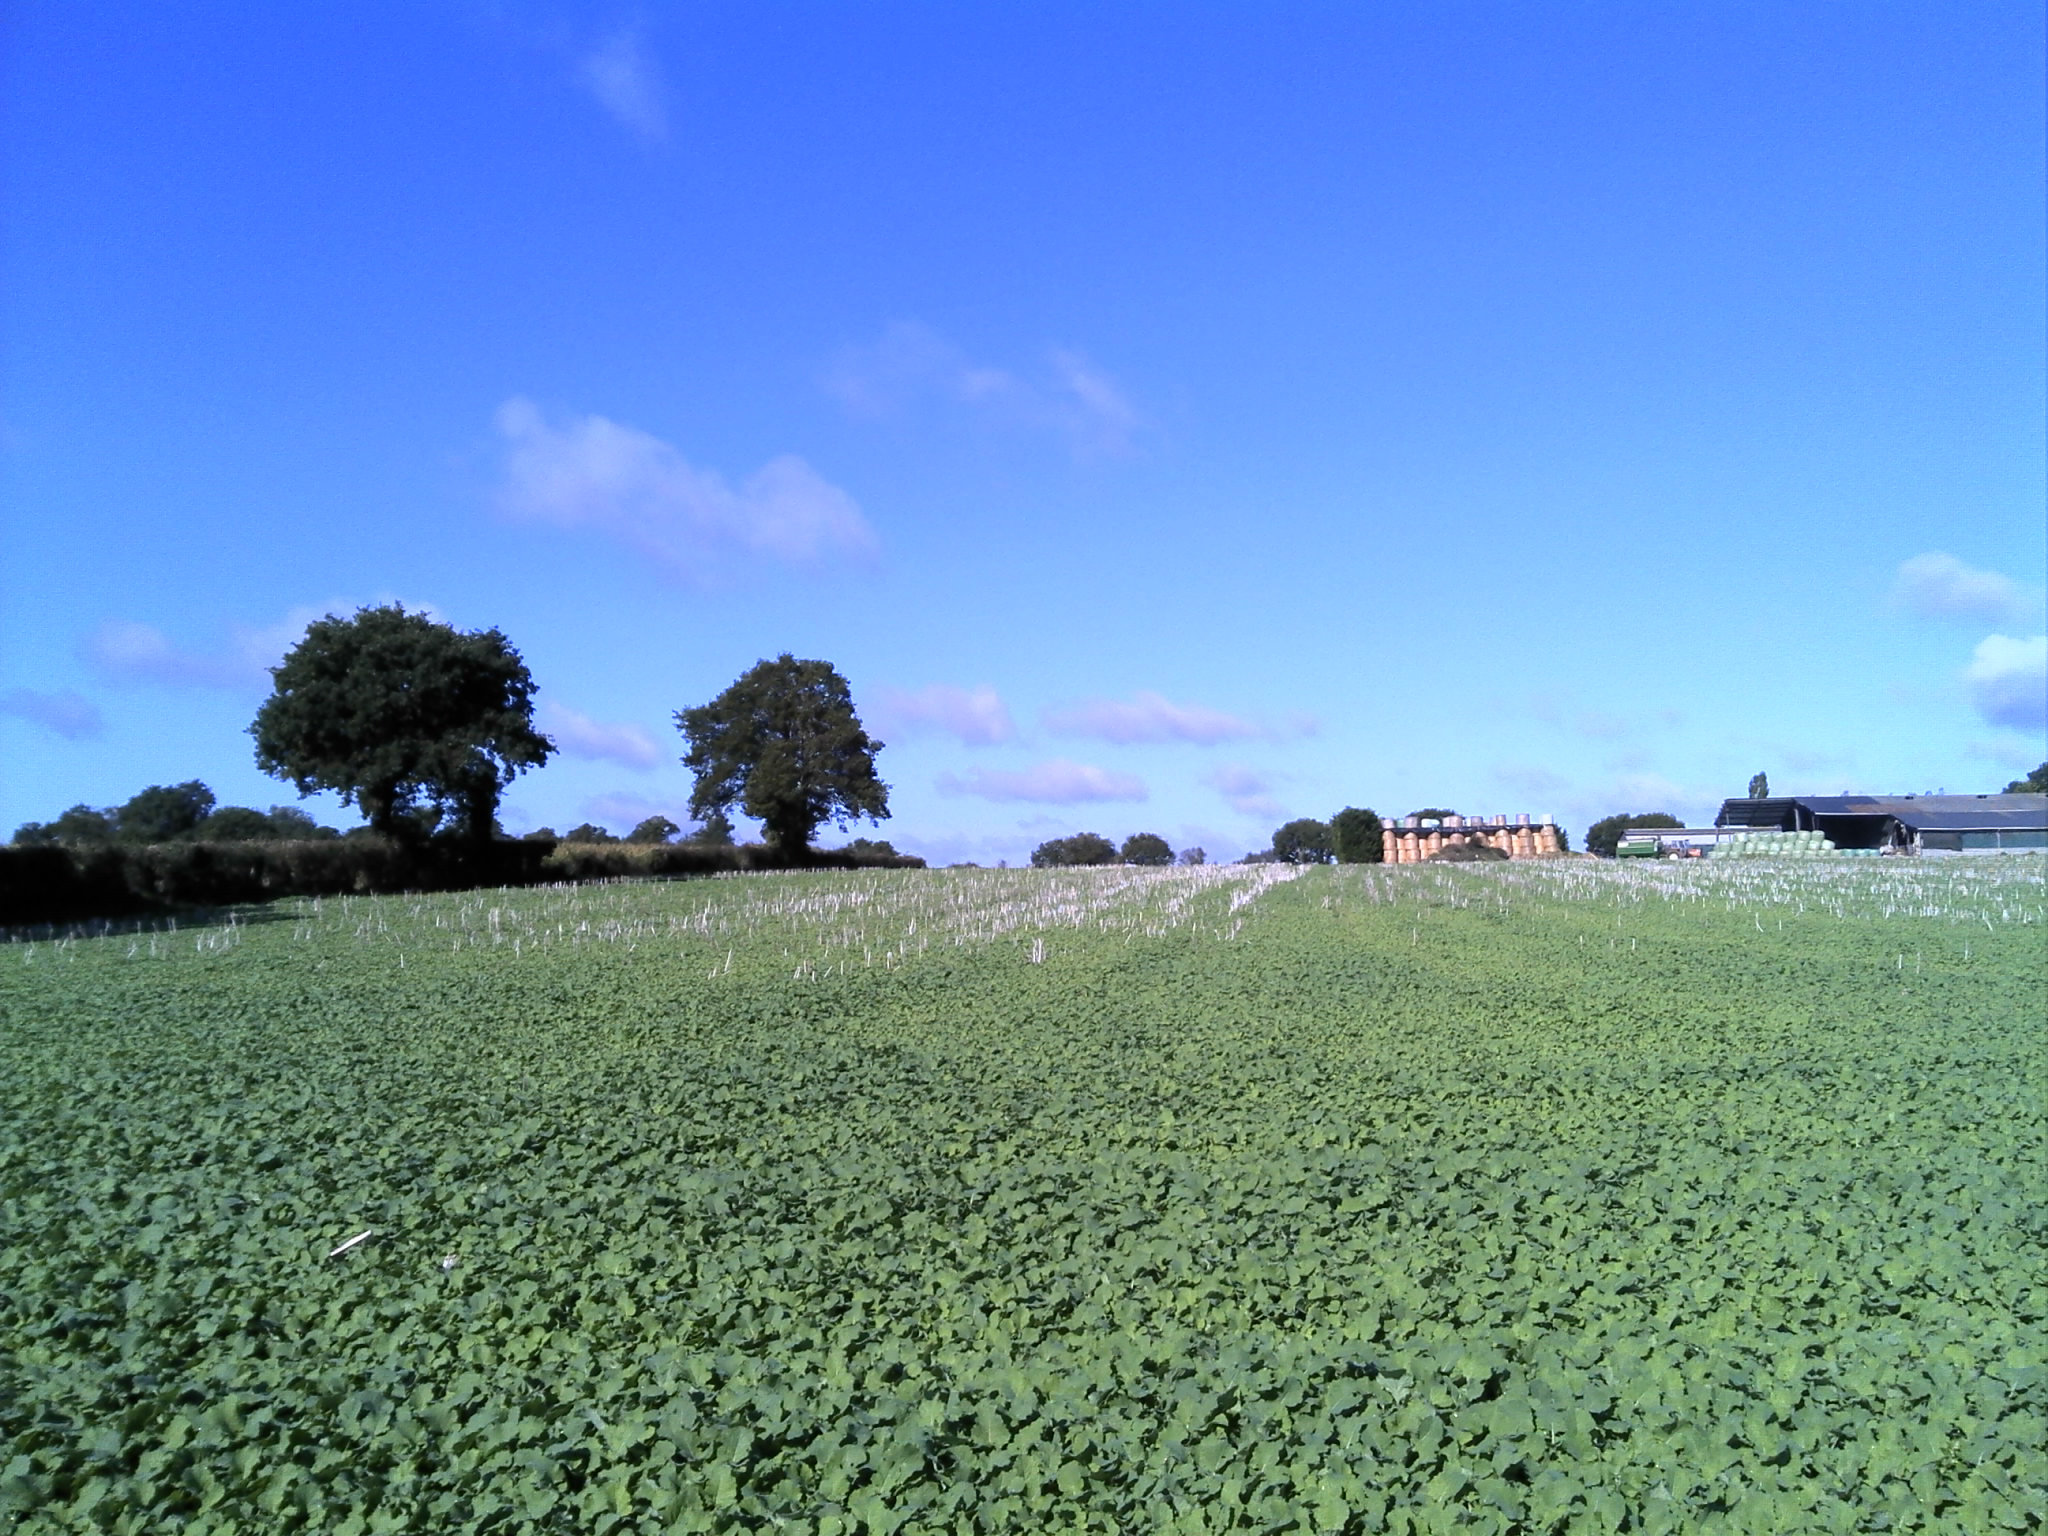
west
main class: Cropland
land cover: Rape and turnip rape
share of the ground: > 75 %
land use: Agriculture (excluding fallow land and kitchen gardens)
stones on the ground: < 10 %
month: September
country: FR
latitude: 47.9340
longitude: 0.6485
